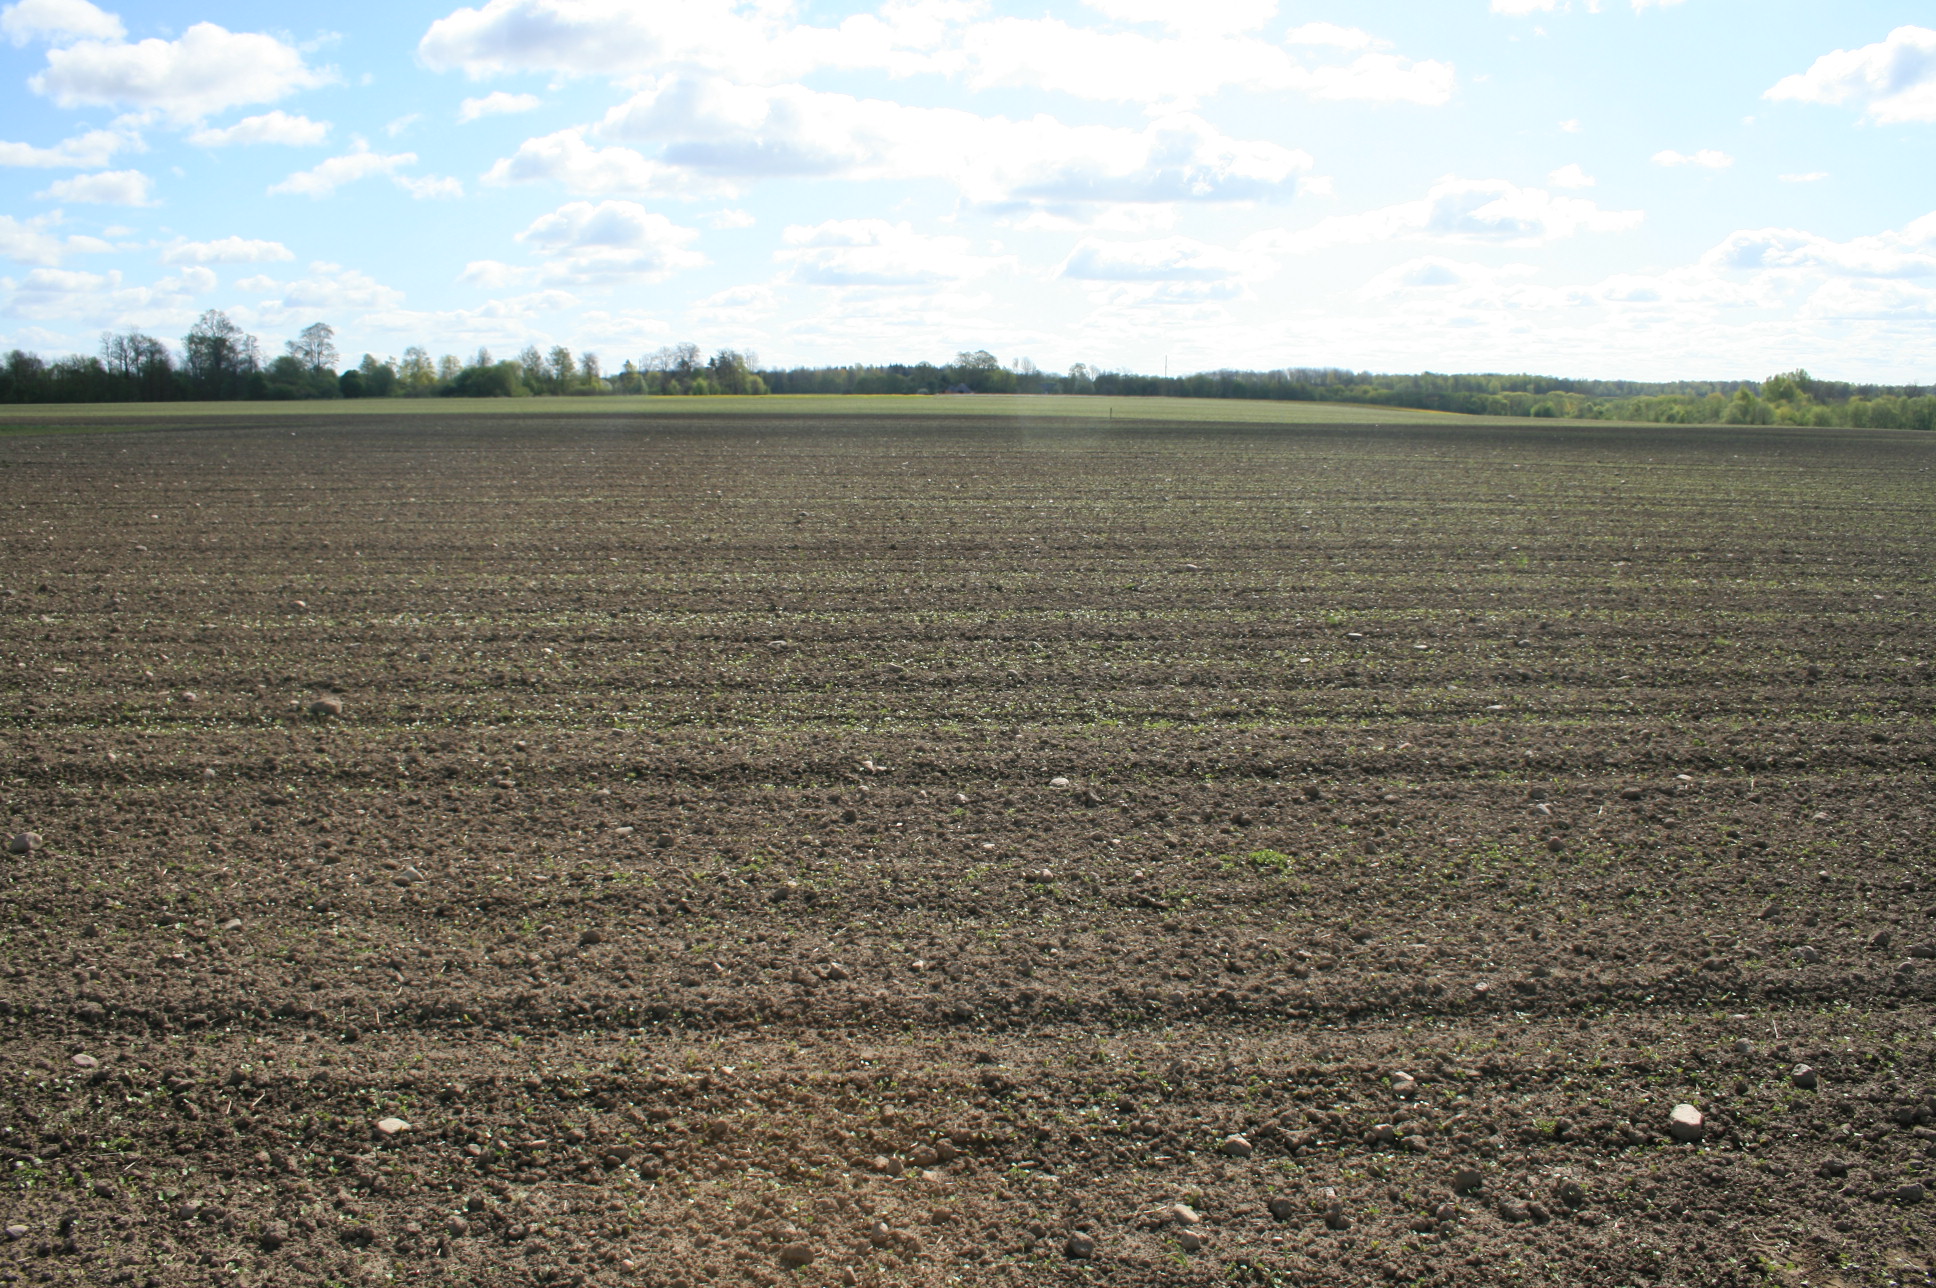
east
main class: Cropland
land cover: Dry pulses
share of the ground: < 10 %
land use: Agriculture (excluding fallow land and kitchen gardens)
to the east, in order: Dry pulses
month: May
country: LT
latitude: 56.2284
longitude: 21.5447
